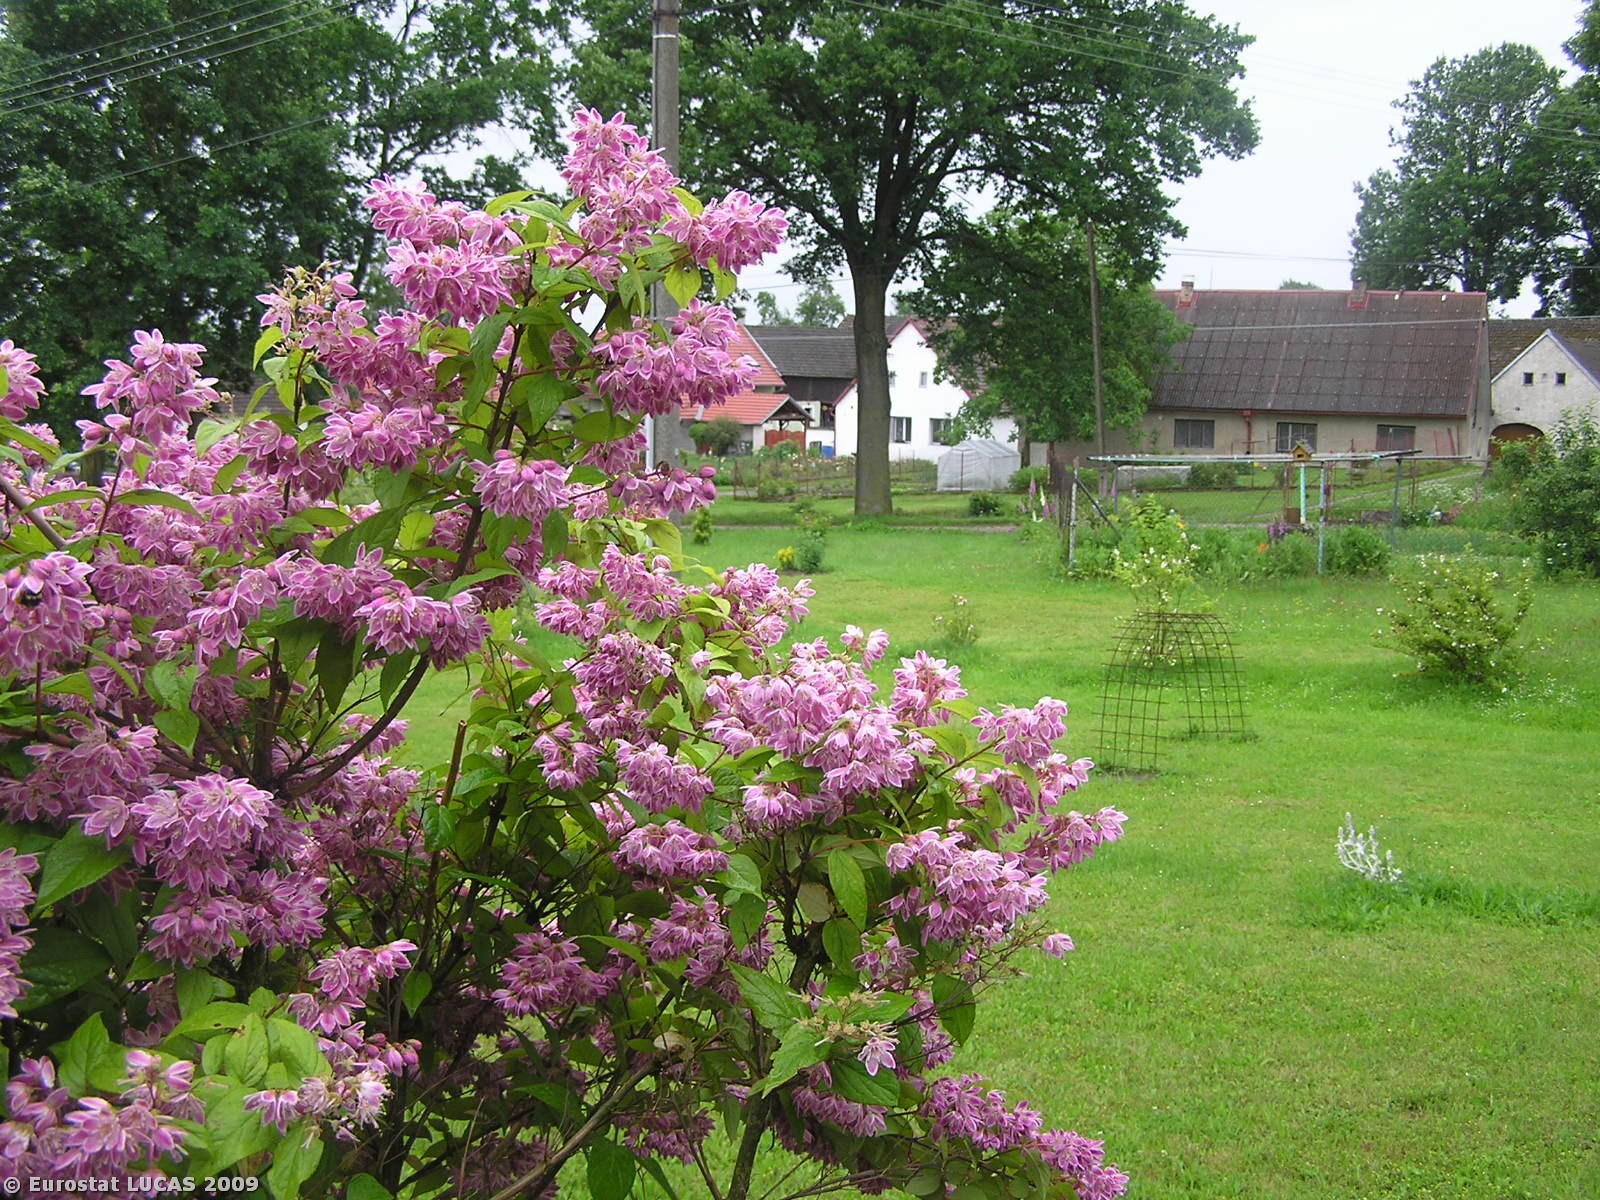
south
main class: Grassland
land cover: Grassland with sparse tree/shrub cover
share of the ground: > 75 %
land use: Residential
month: June
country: CZ
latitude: 49.1936
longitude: 14.9559
